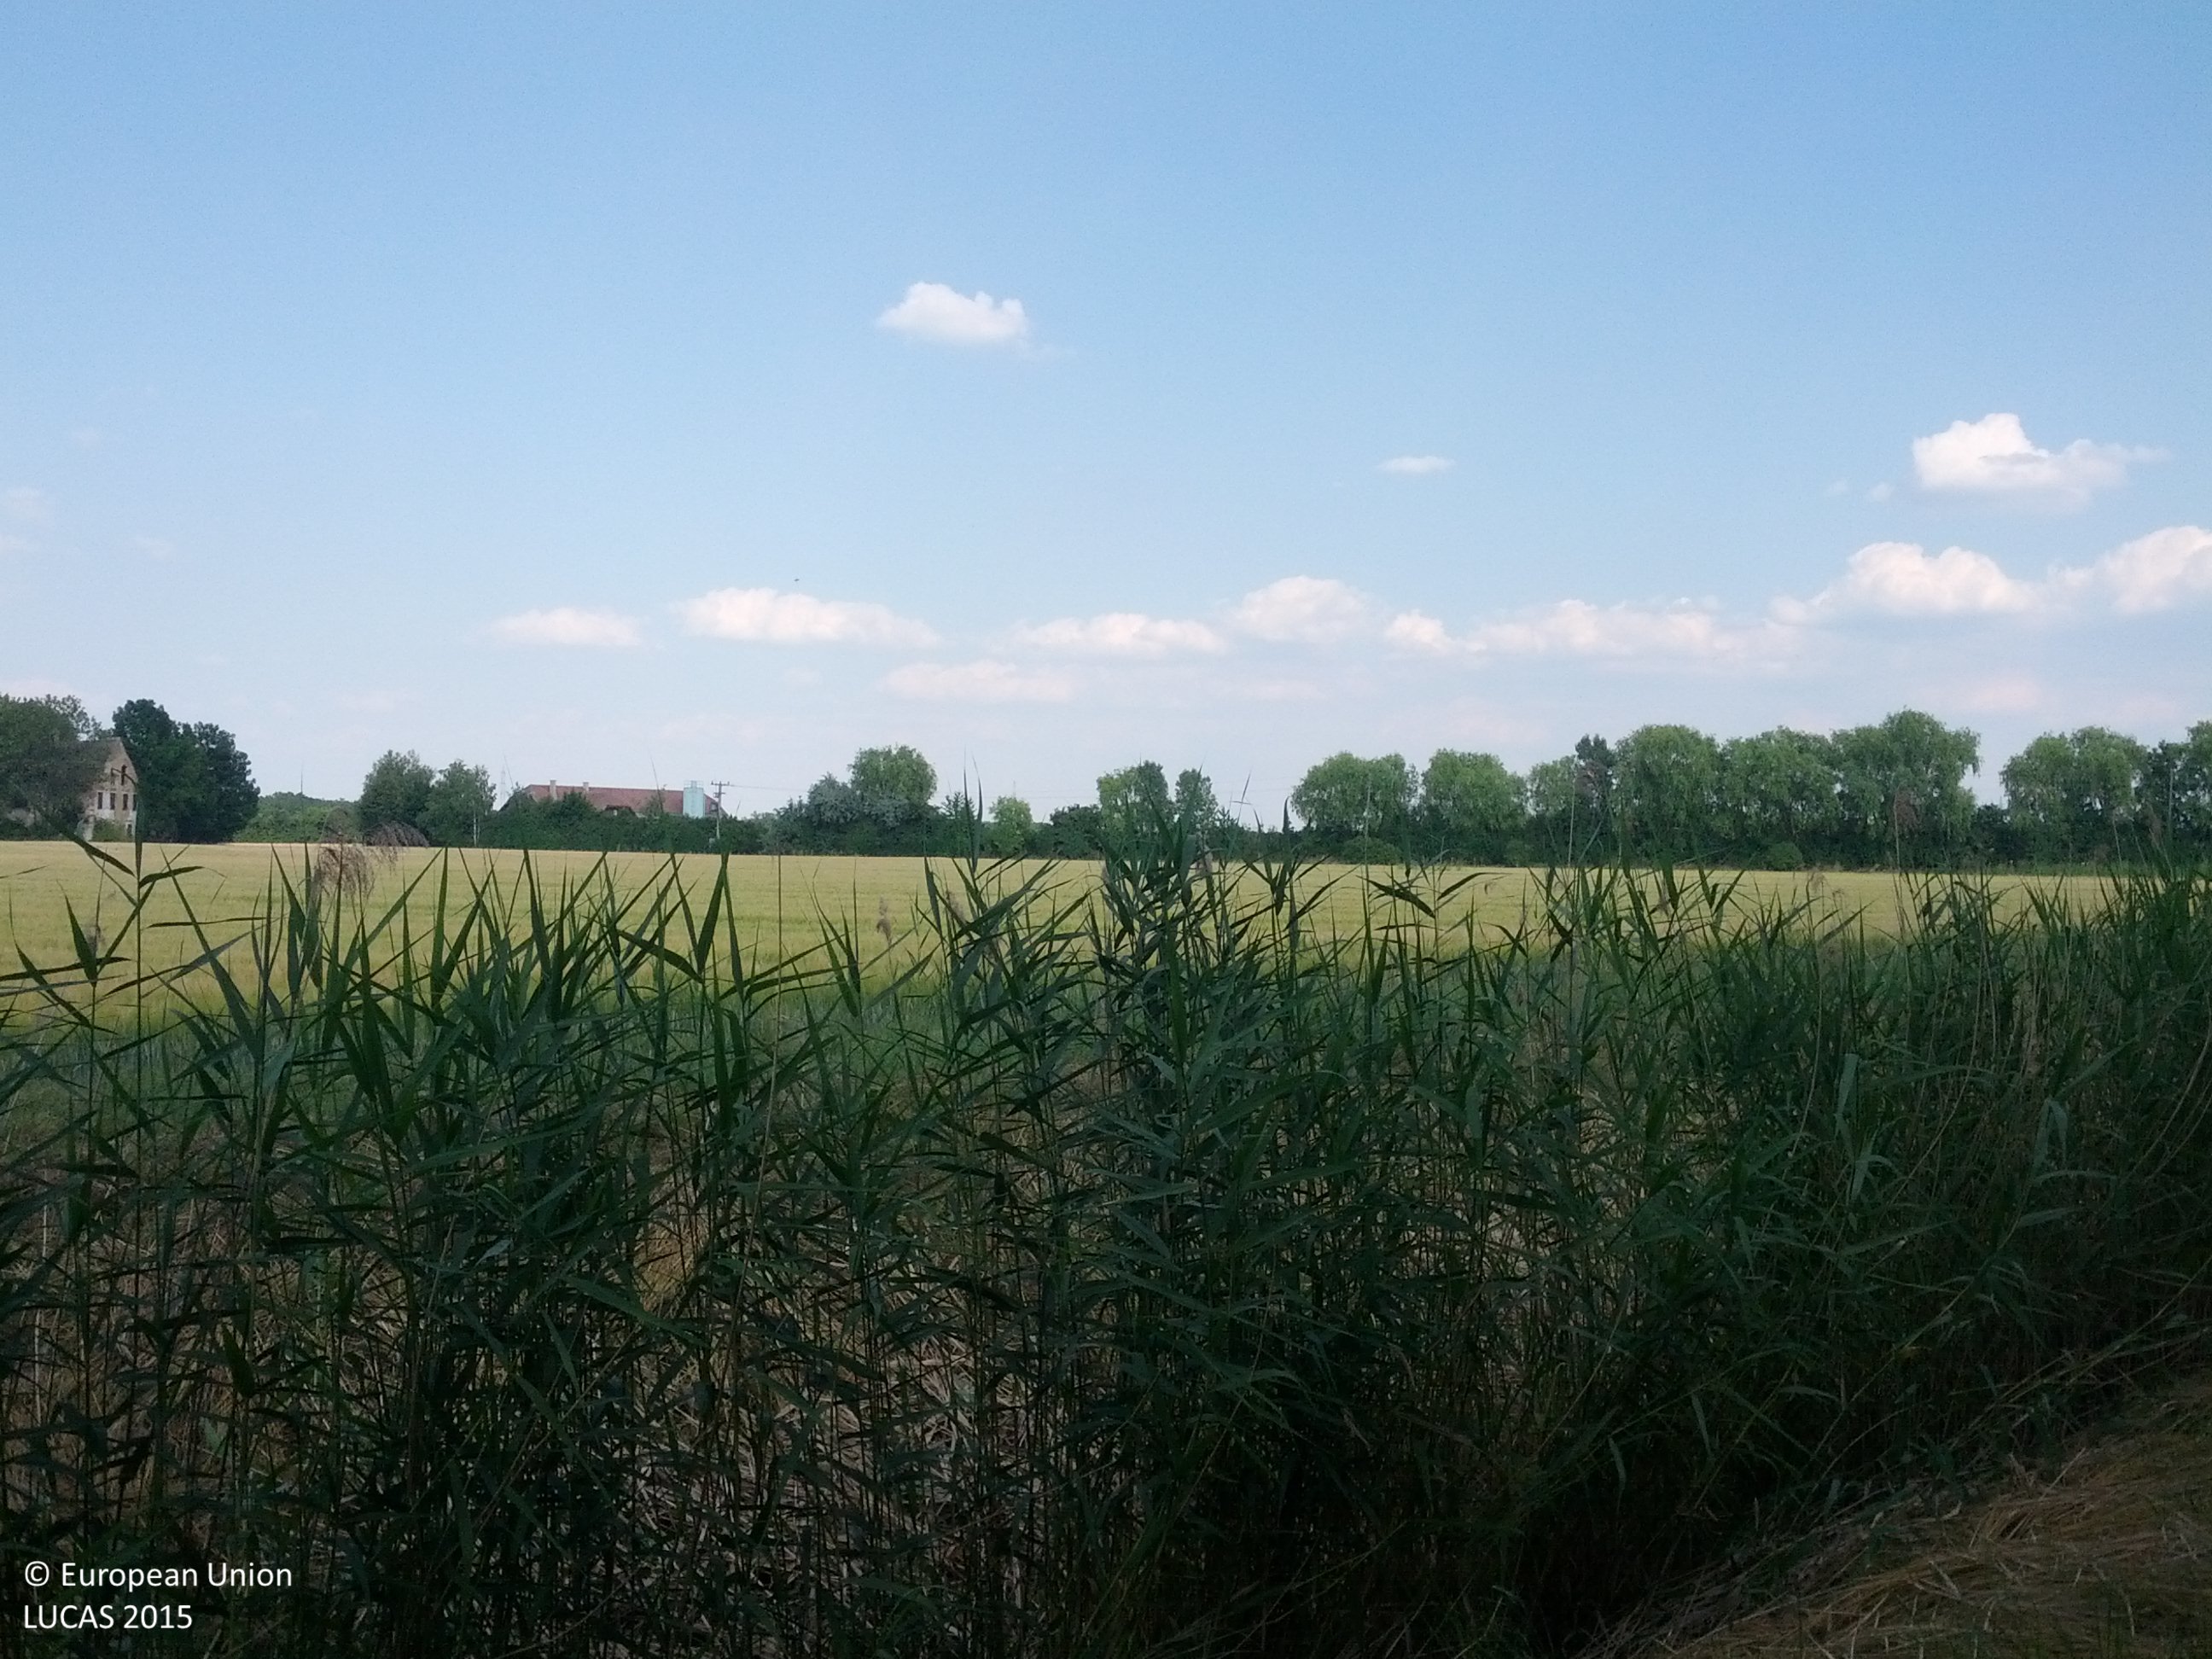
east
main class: Grassland
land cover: Grassland without tree/shrub cover
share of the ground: > 75 %
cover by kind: herbaceous plants 100 %
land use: Semi-natural and natural areas not in use
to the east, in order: Grassland without tree/shrub cover; Rivers and streams; Inland marshes; Common wheat; Grassland without tree/shrub cover; Tracks; Grass margins; Barley; Electric lines; Grass margins; Paved roads, cycling and walking lanes; Grass margins; Broadleaved woodland
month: July
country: AT
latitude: 48.5896
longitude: 16.8270
